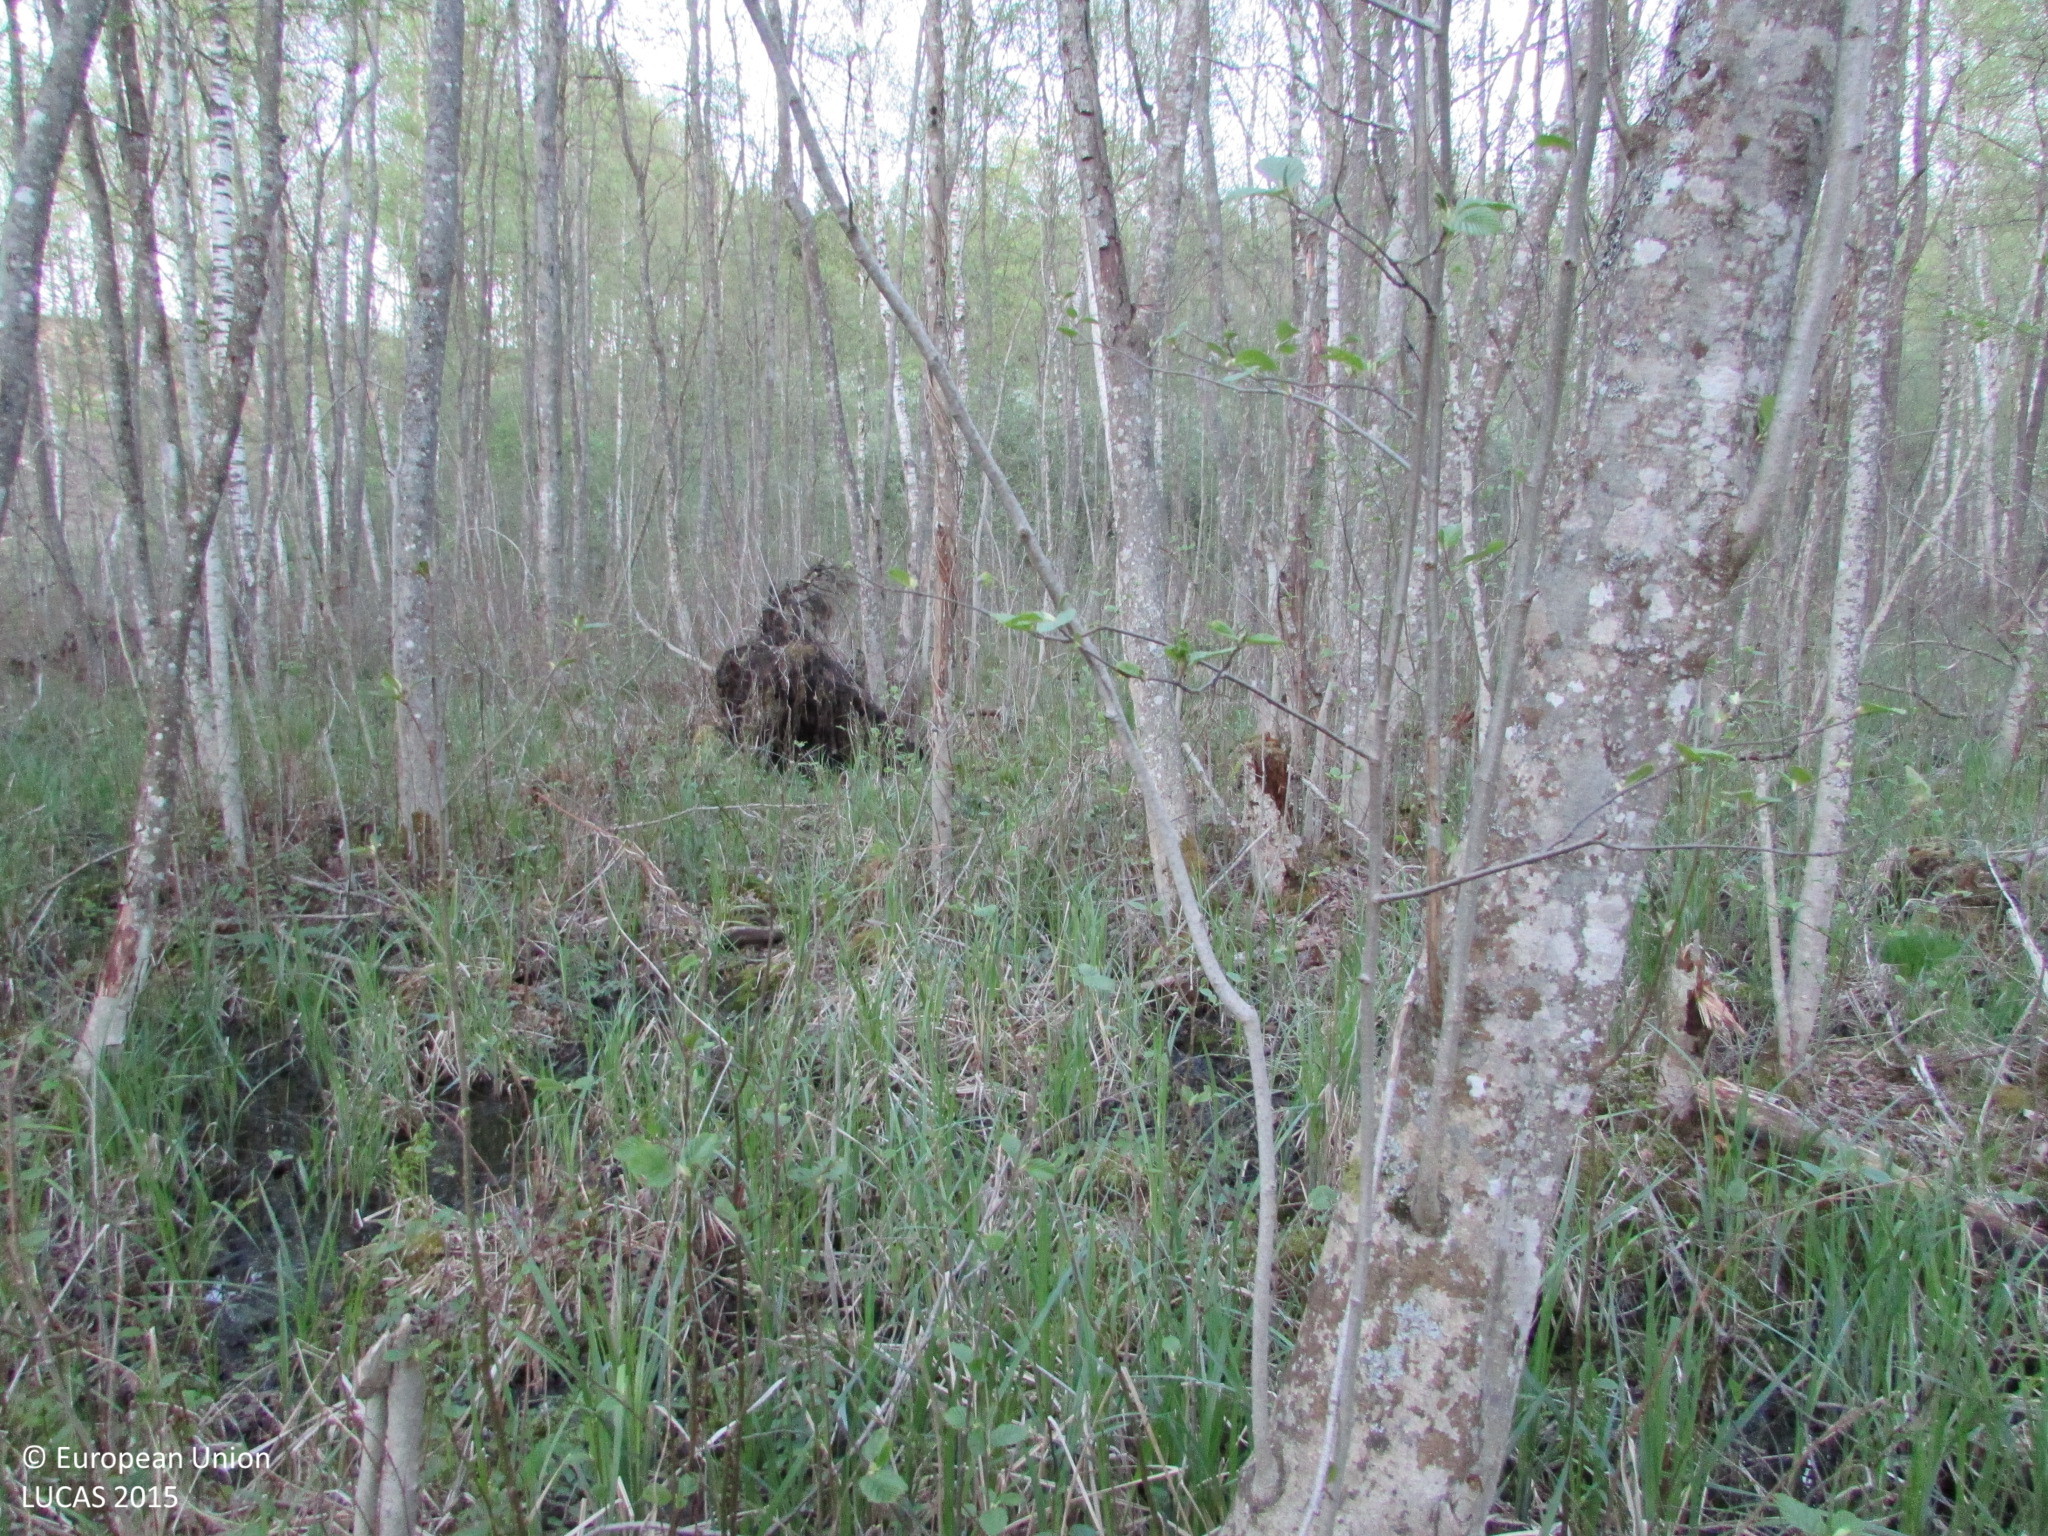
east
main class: Woodland
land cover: Broadleaved woodland
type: floodplain forest
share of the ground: > 75 %
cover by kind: broadleaved forest trees 80 %, herbaceous plants 10 %, shrubs 5 %
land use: Forestry
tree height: > 5 m
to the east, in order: Broadleaved woodland; Grassland without tree/shrub cover
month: May
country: LV
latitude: 55.8758
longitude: 27.3597
